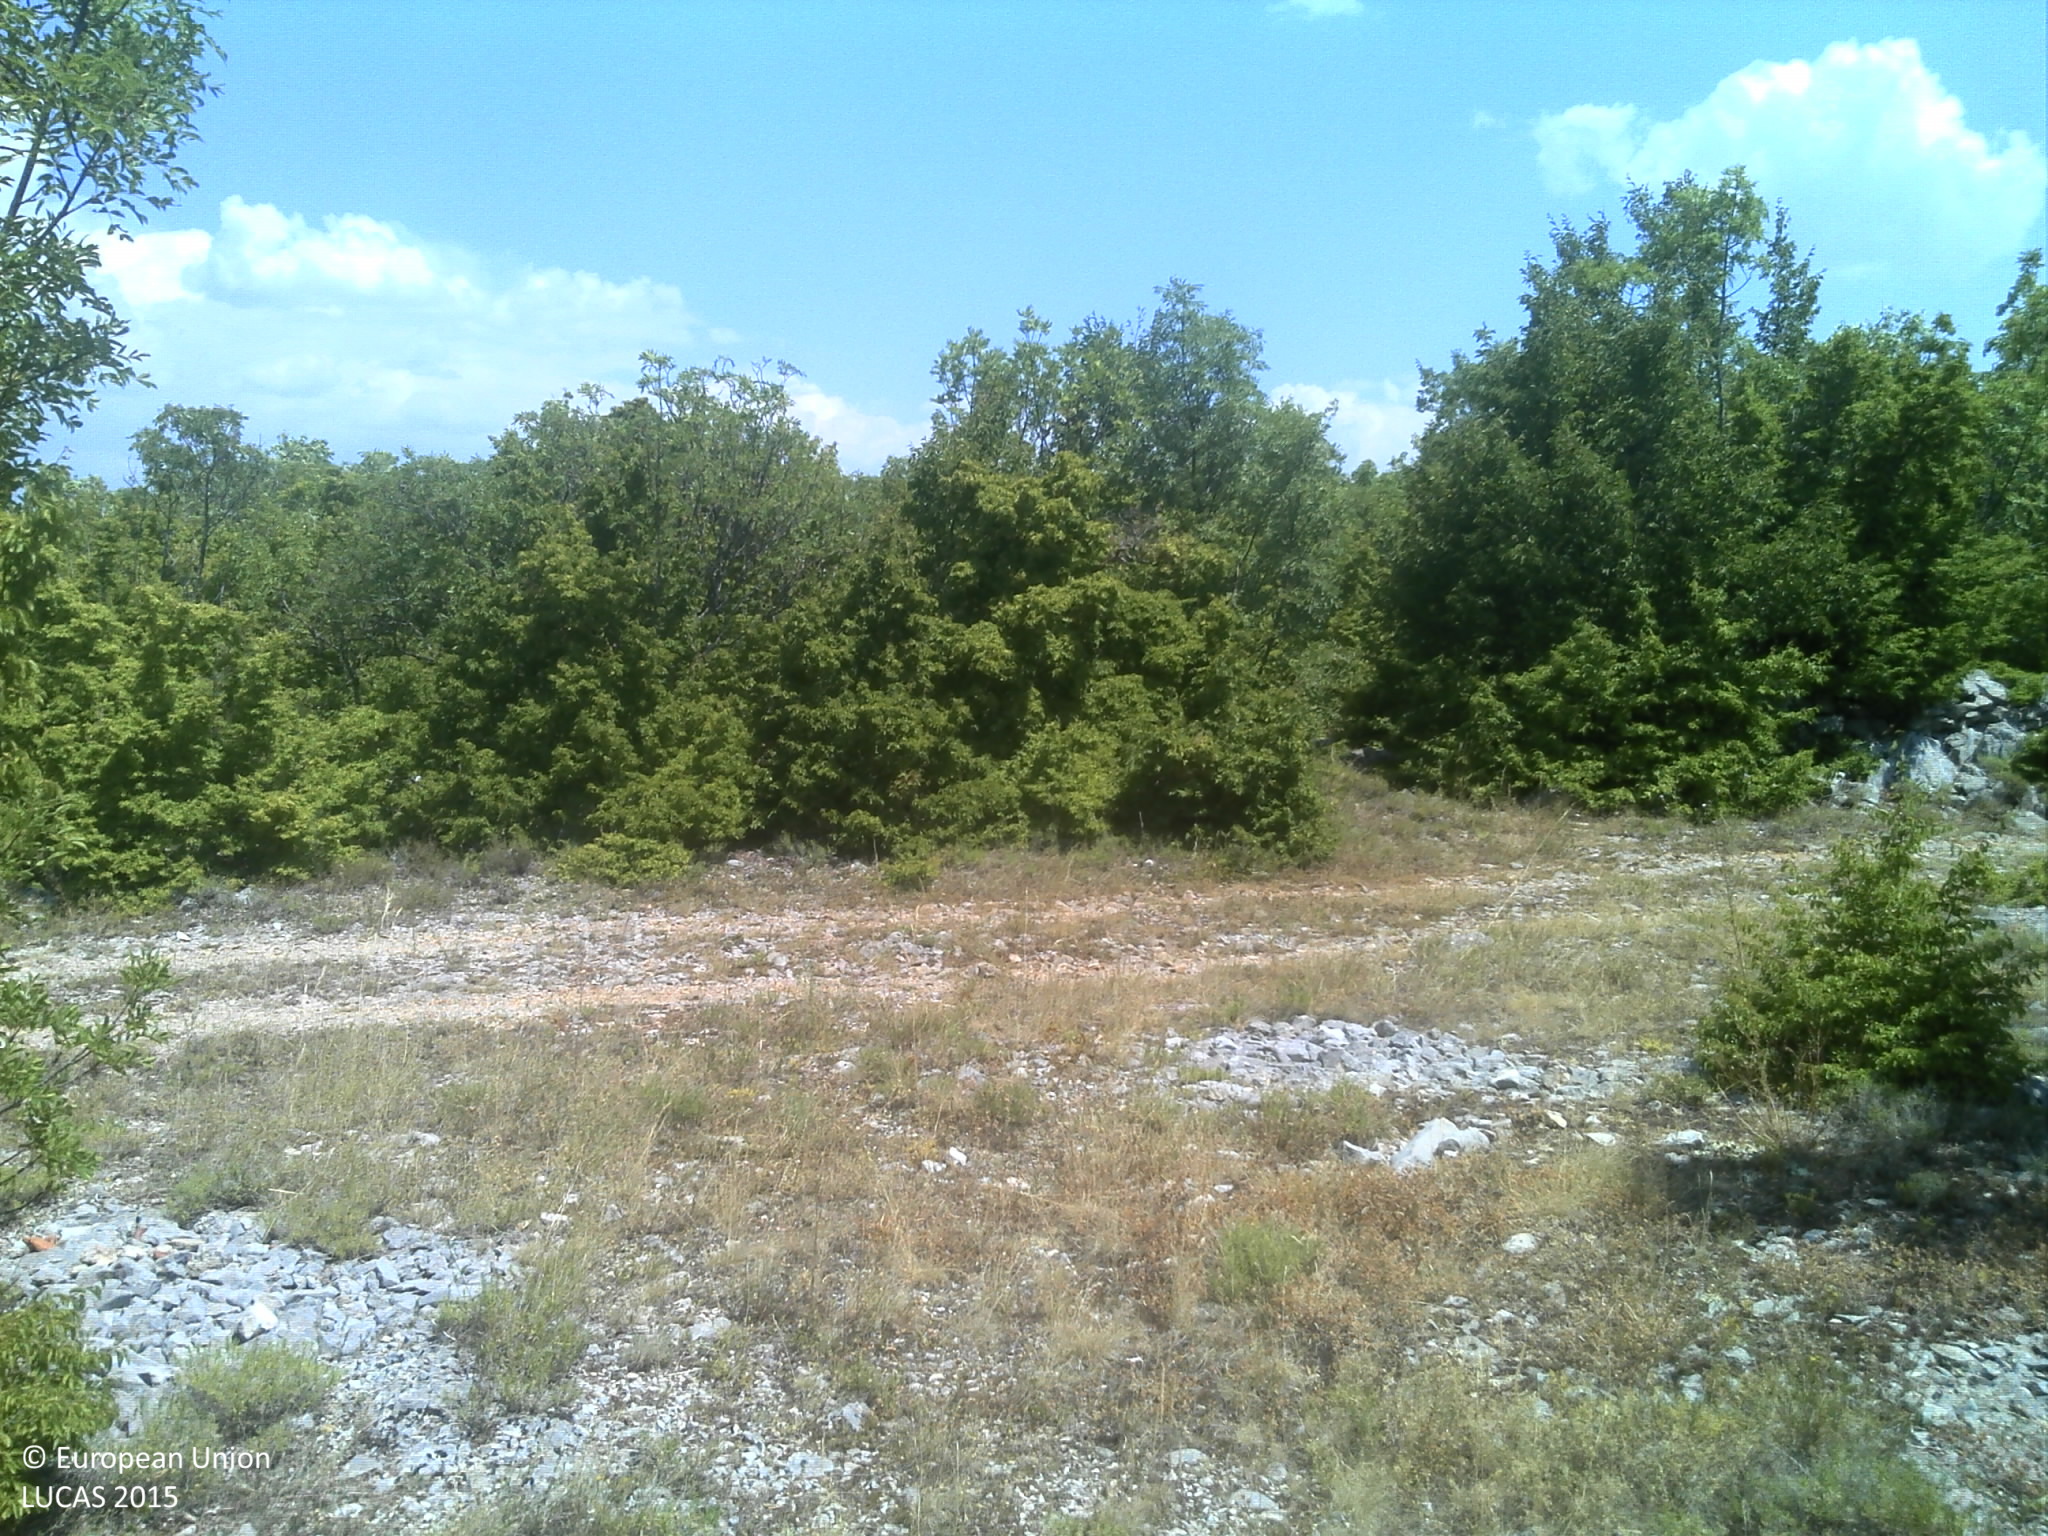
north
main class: Shrubland
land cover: Shrubland with sparse tree cover
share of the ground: > 75 %
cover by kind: shrubs 70 %, herbaceous plants 15 %, broadleaved forest trees 5 %, consolidated bare surface 5 %, unconsolidated bare surface 5 %
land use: Semi-natural and natural areas not in use
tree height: > 5 m
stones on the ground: < 10 %
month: July
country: HR
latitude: 43.4949
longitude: 17.0530
